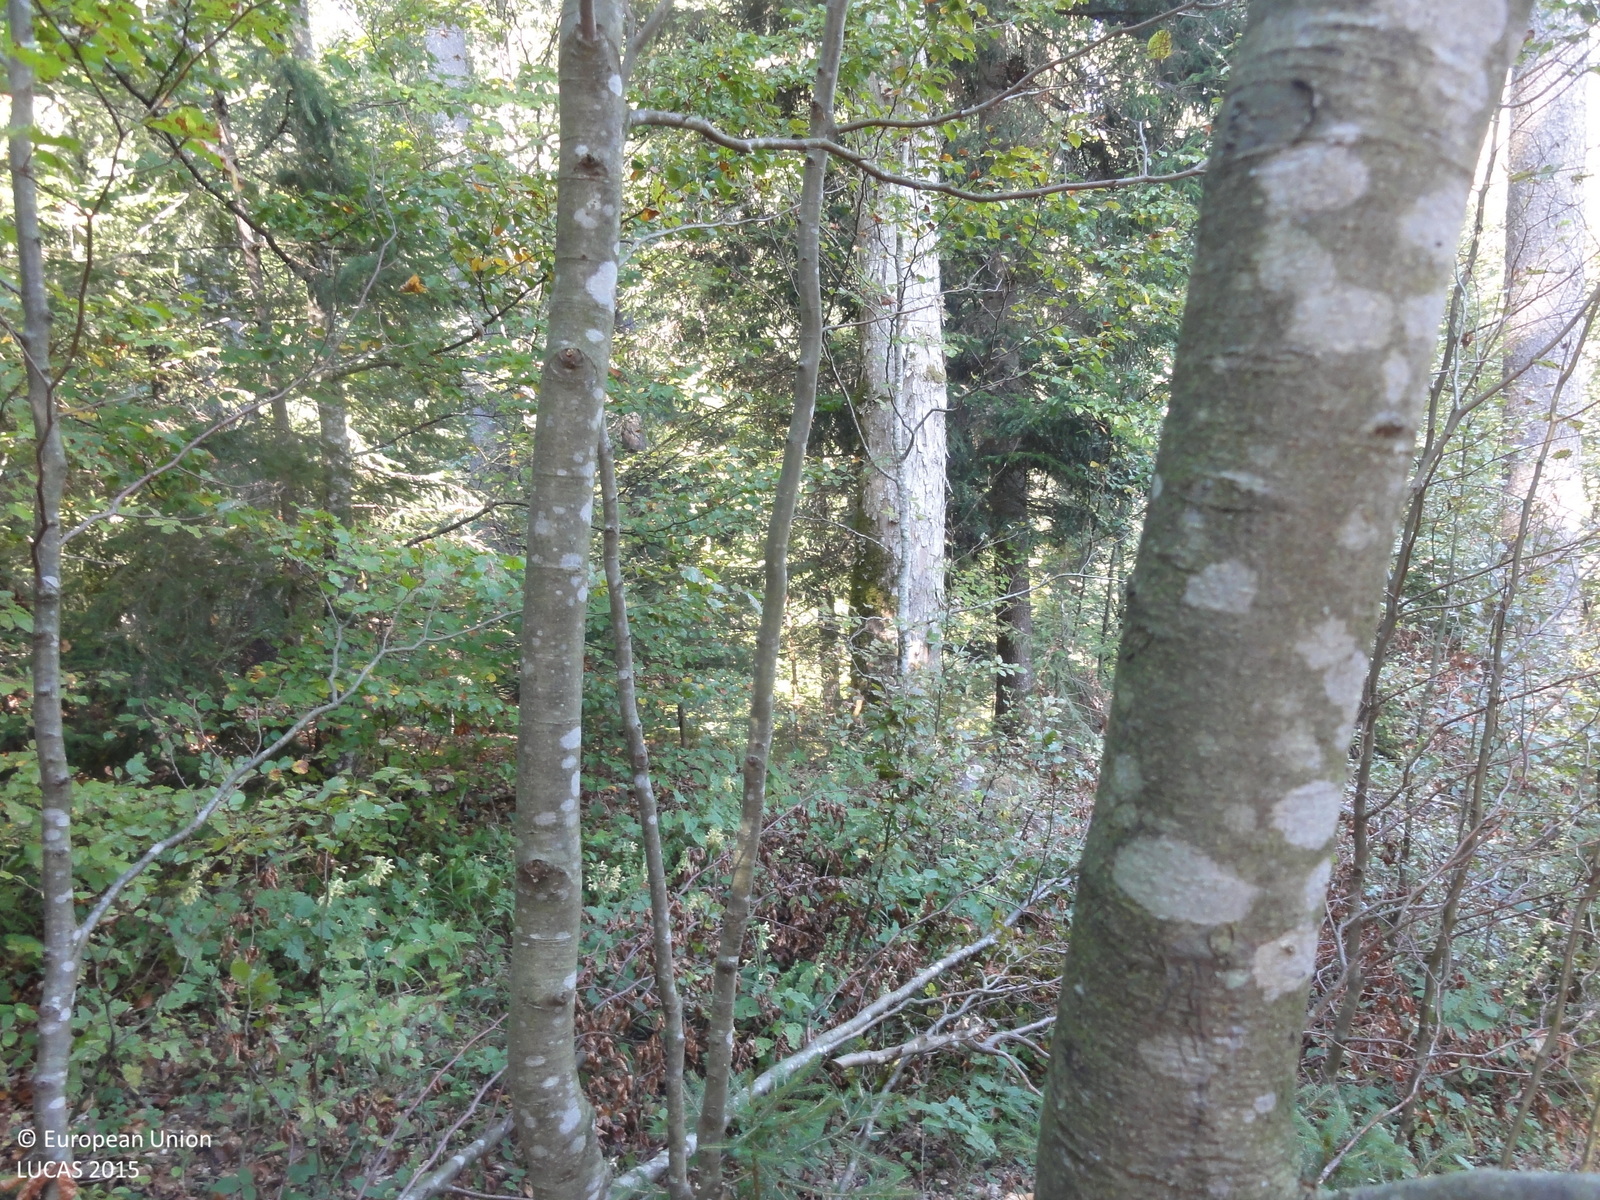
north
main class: Woodland
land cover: Spruce dominated mixed woodland
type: mountainous beech forest
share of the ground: > 75 %
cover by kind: broadleaved forest trees 50 %, coniferous forest trees 30 %, herbaceous plants 10 %, consolidated bare surface 5 %, unconsolidated bare surface 5 %
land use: Forestry
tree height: > 5 m
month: September
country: SI
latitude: 45.7112
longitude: 14.9931
